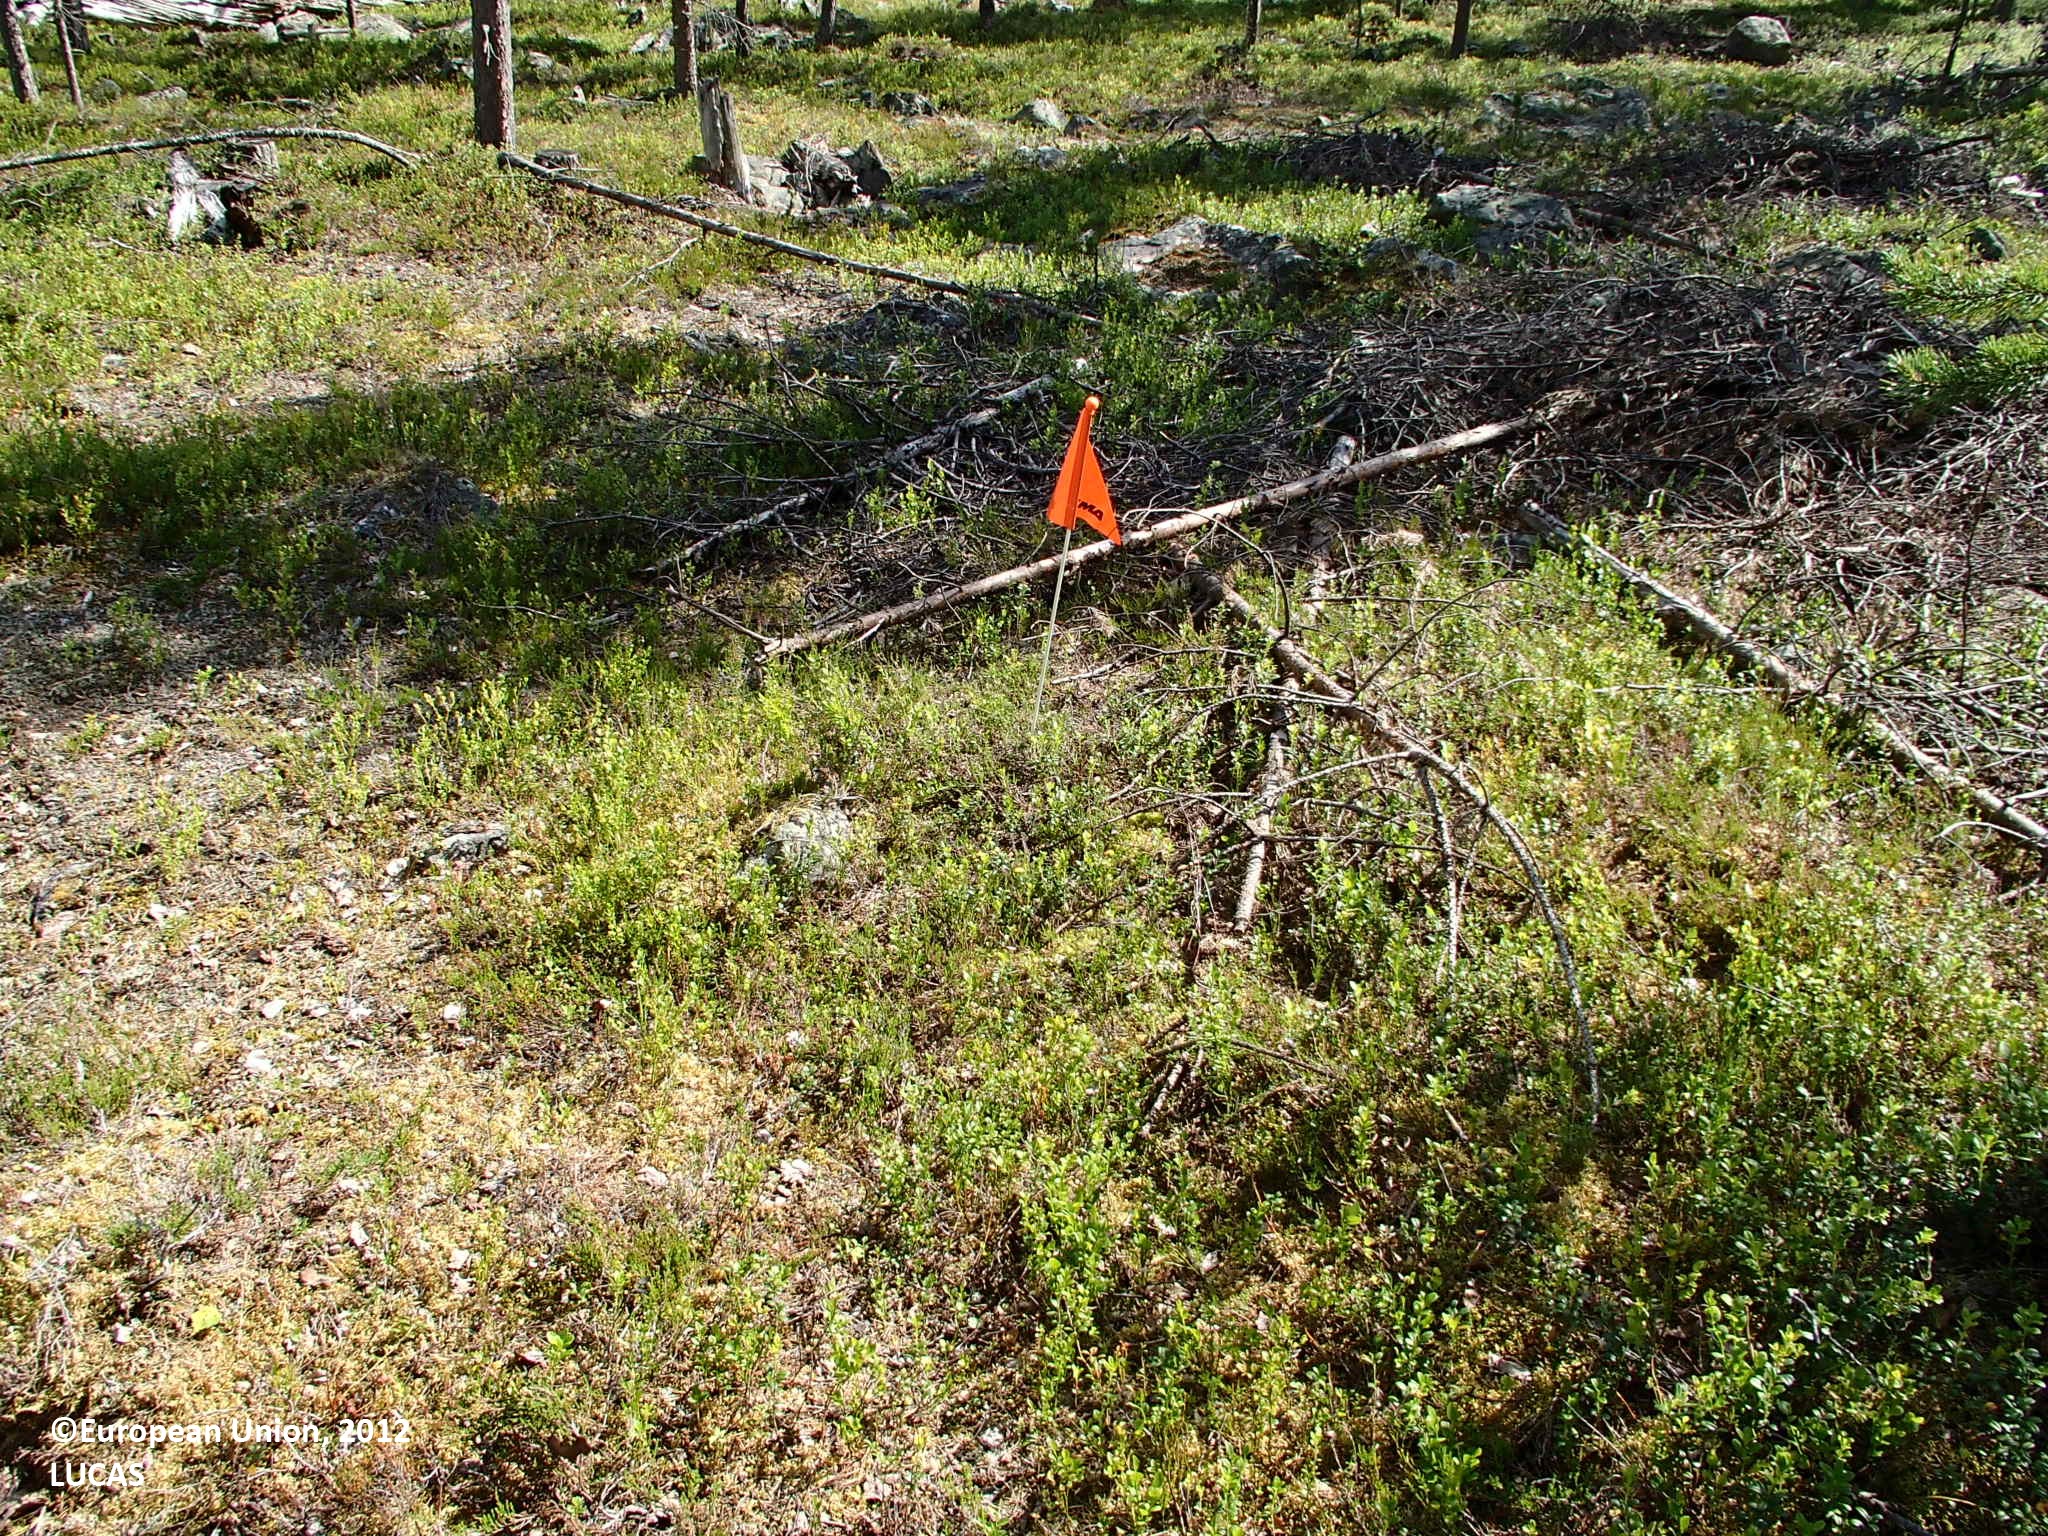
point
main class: Woodland
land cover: Pine dominated mixed woodland
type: boreal forest
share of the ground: 25 - 50 %
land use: Forestry
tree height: > 5 m
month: July
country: FI
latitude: 67.1804
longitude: 25.5592
